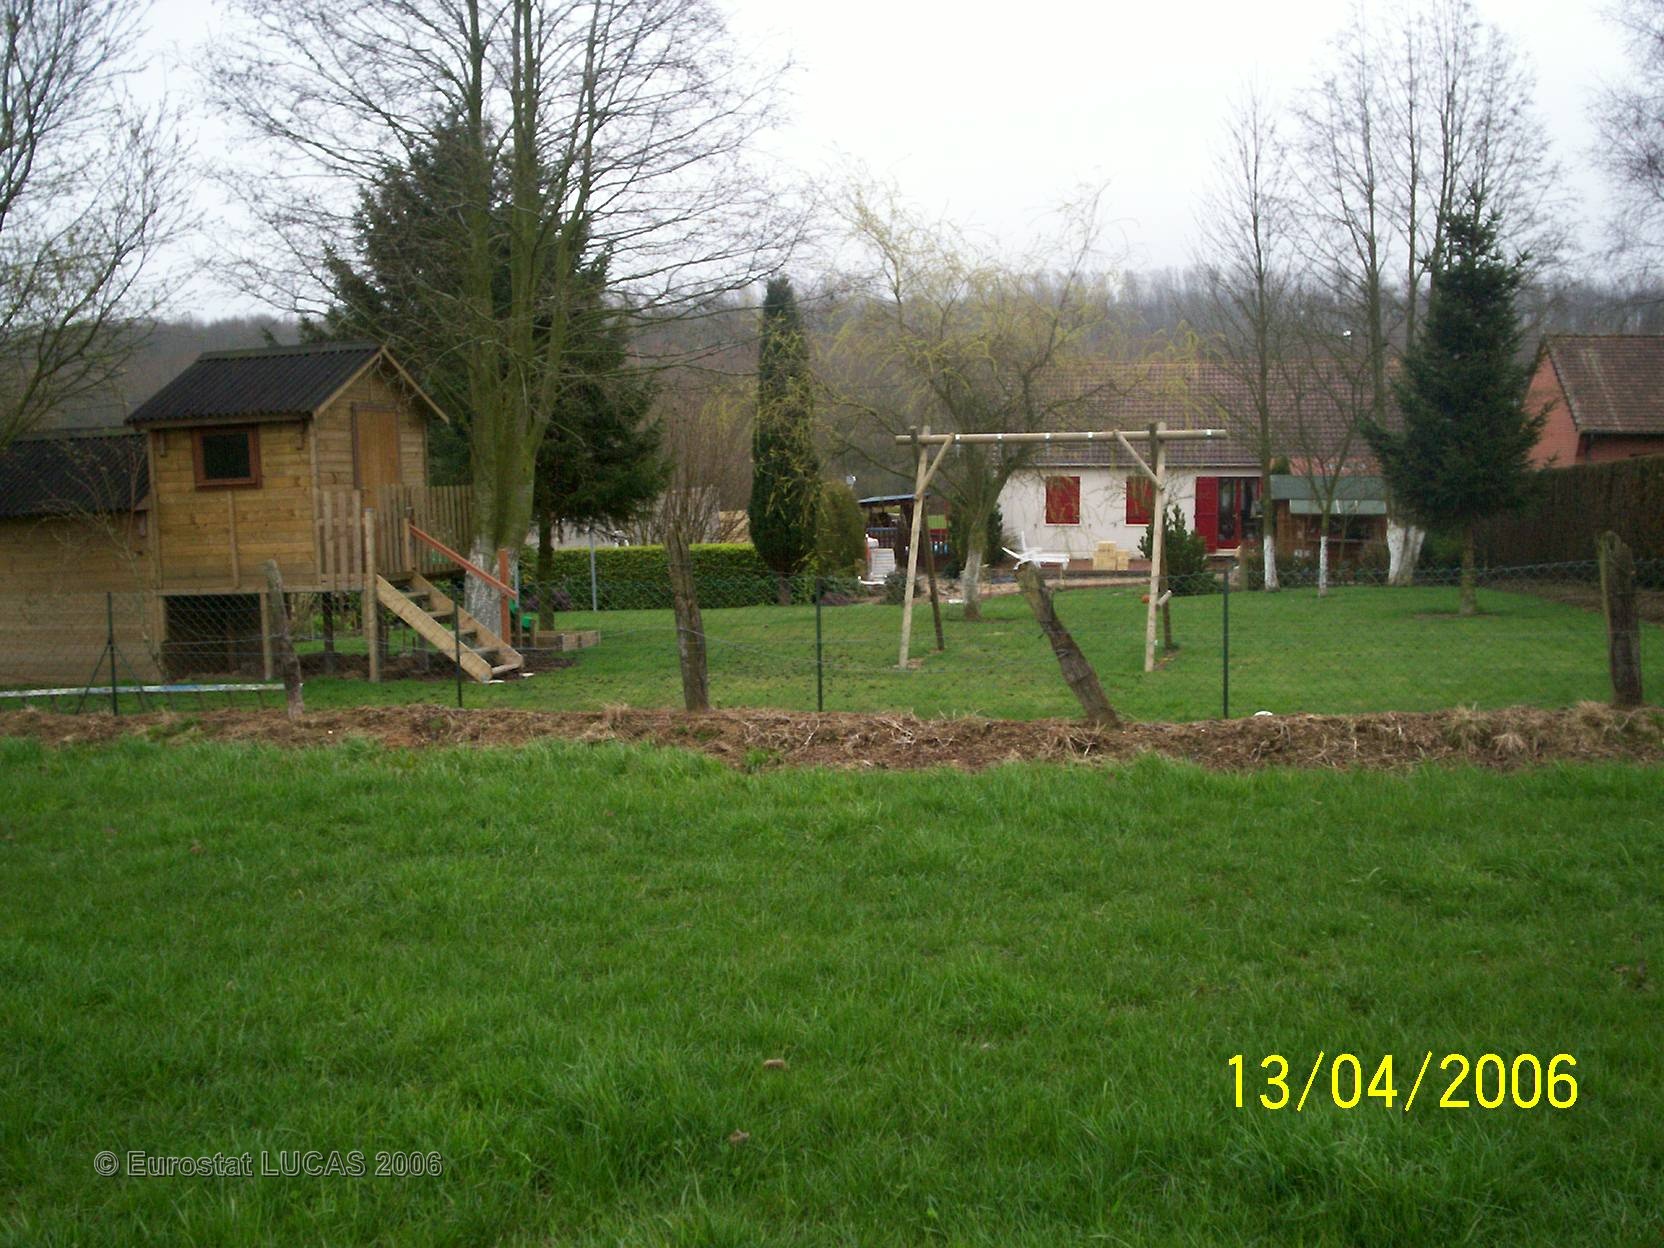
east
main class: Grassland
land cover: Grassland without tree/shrub cover
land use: Agriculture (excluding fallow land and kitchen gardens)
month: April
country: FR
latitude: 50.4397
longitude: 2.4541
